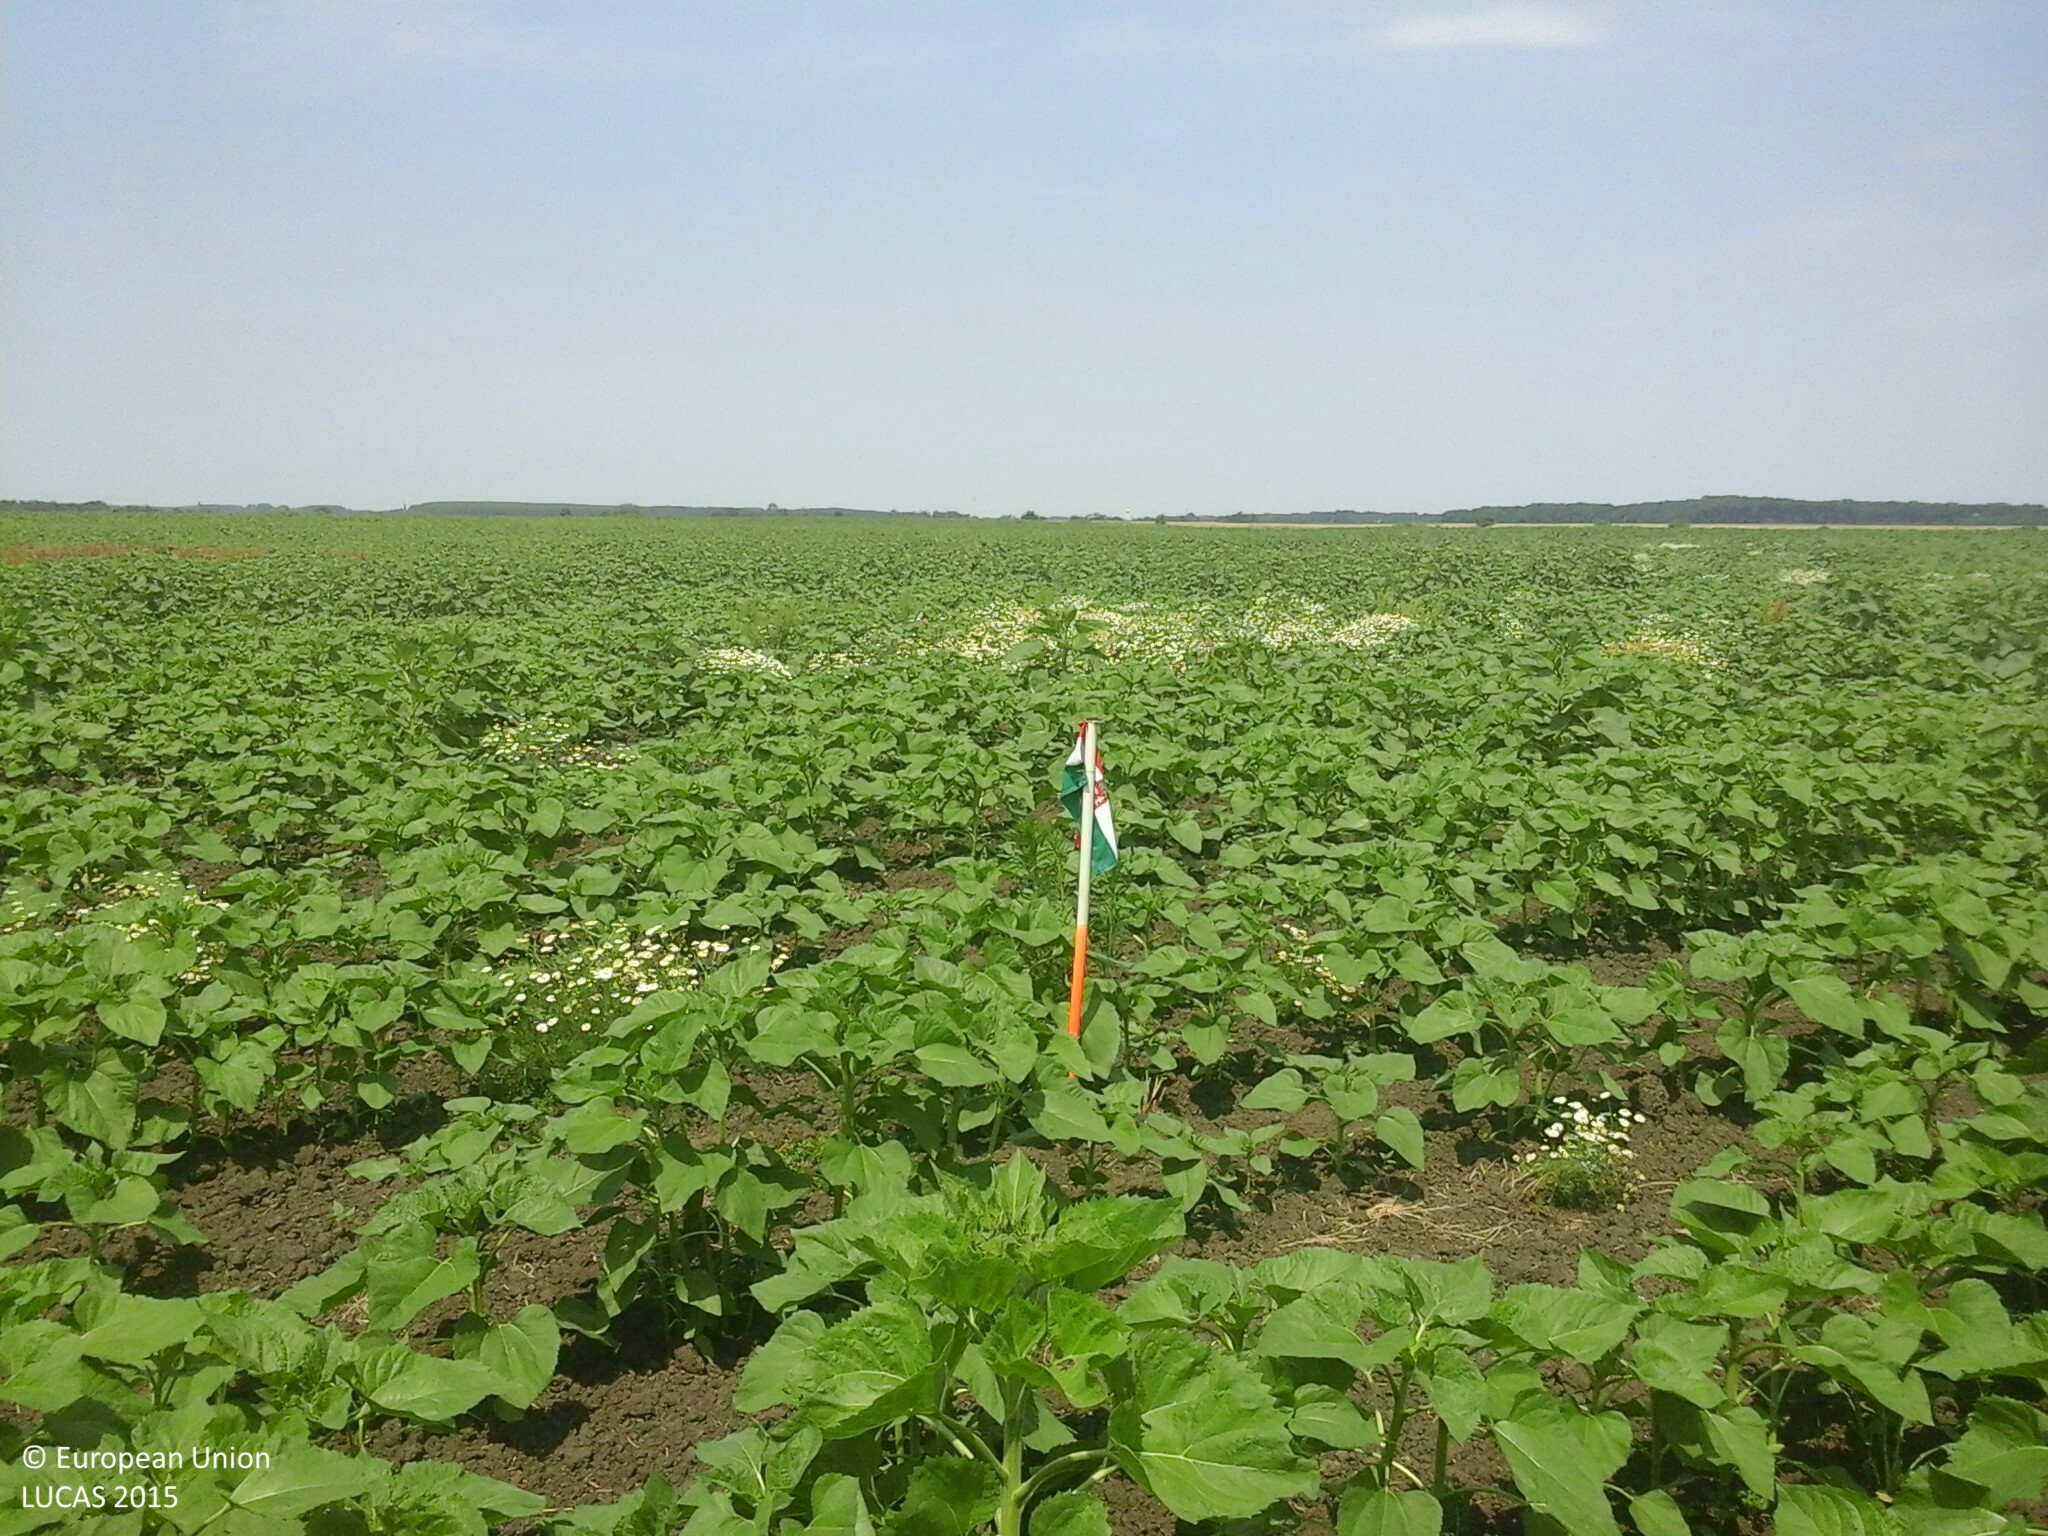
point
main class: Cropland
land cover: Sunflower
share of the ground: 50 - 75 %
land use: Agriculture (excluding fallow land and kitchen gardens)
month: July
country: HU
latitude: 46.8616
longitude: 20.3766
